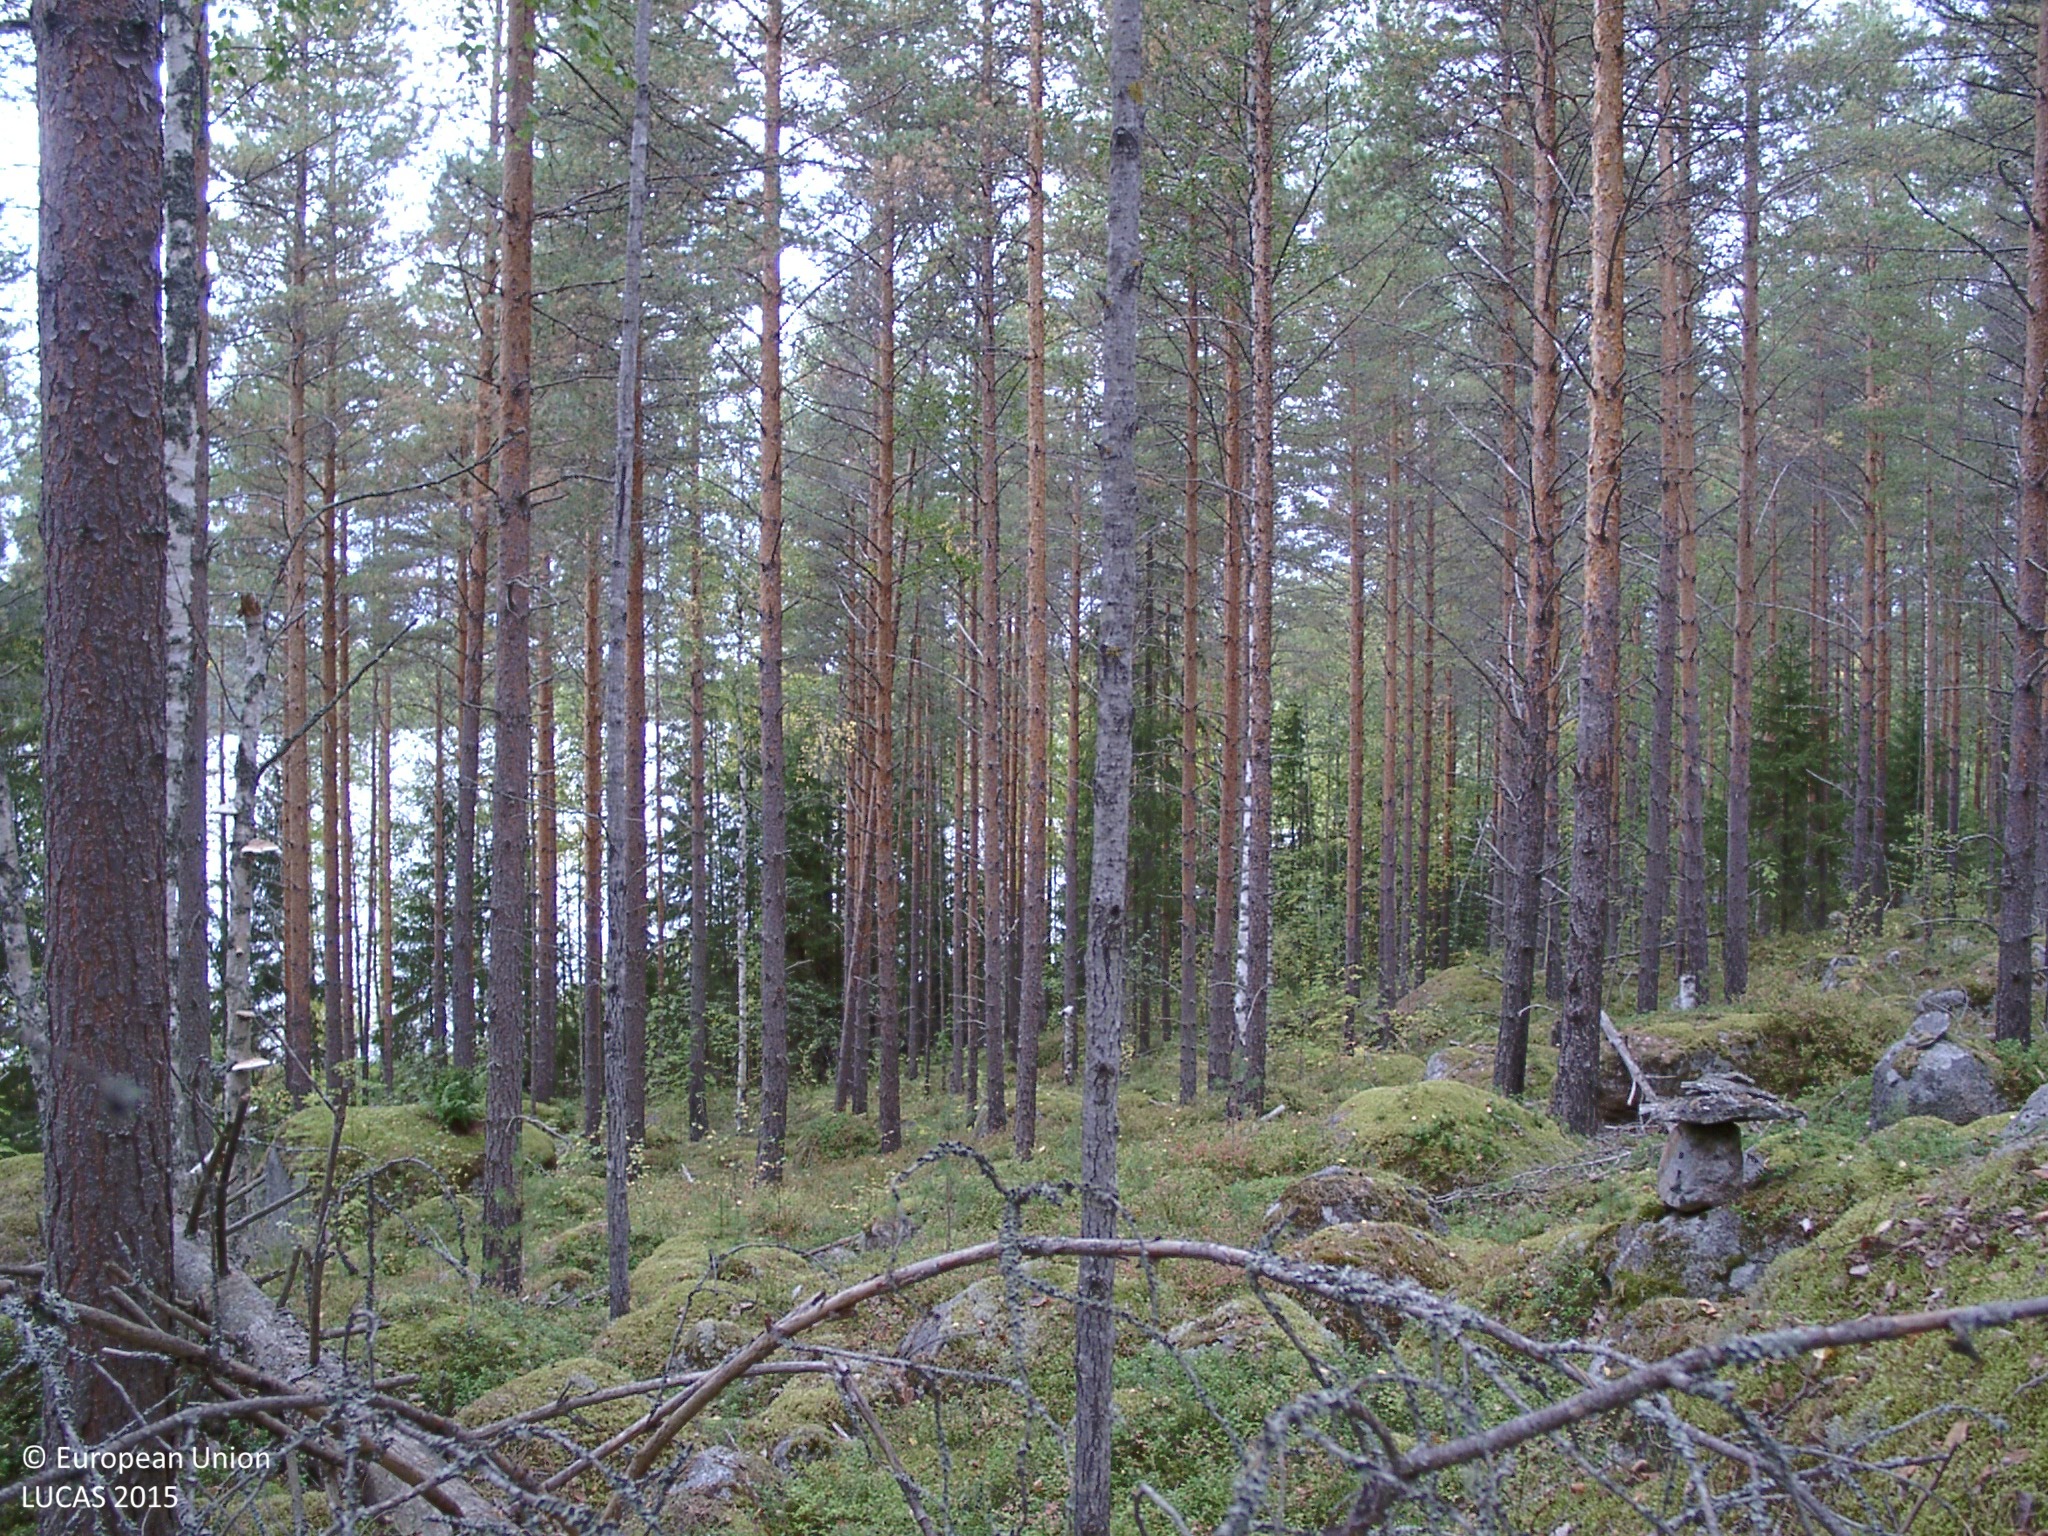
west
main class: Woodland
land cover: Pine dominated mixed woodland
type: boreal forest
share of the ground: 50 - 75 %
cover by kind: coniferous forest trees 50 %, broadleaved forest trees 20 %, lichens and mosses 20 %, shrubs 10 %
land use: Forestry
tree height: > 5 m
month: September
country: FI
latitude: 62.5661
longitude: 25.7797
